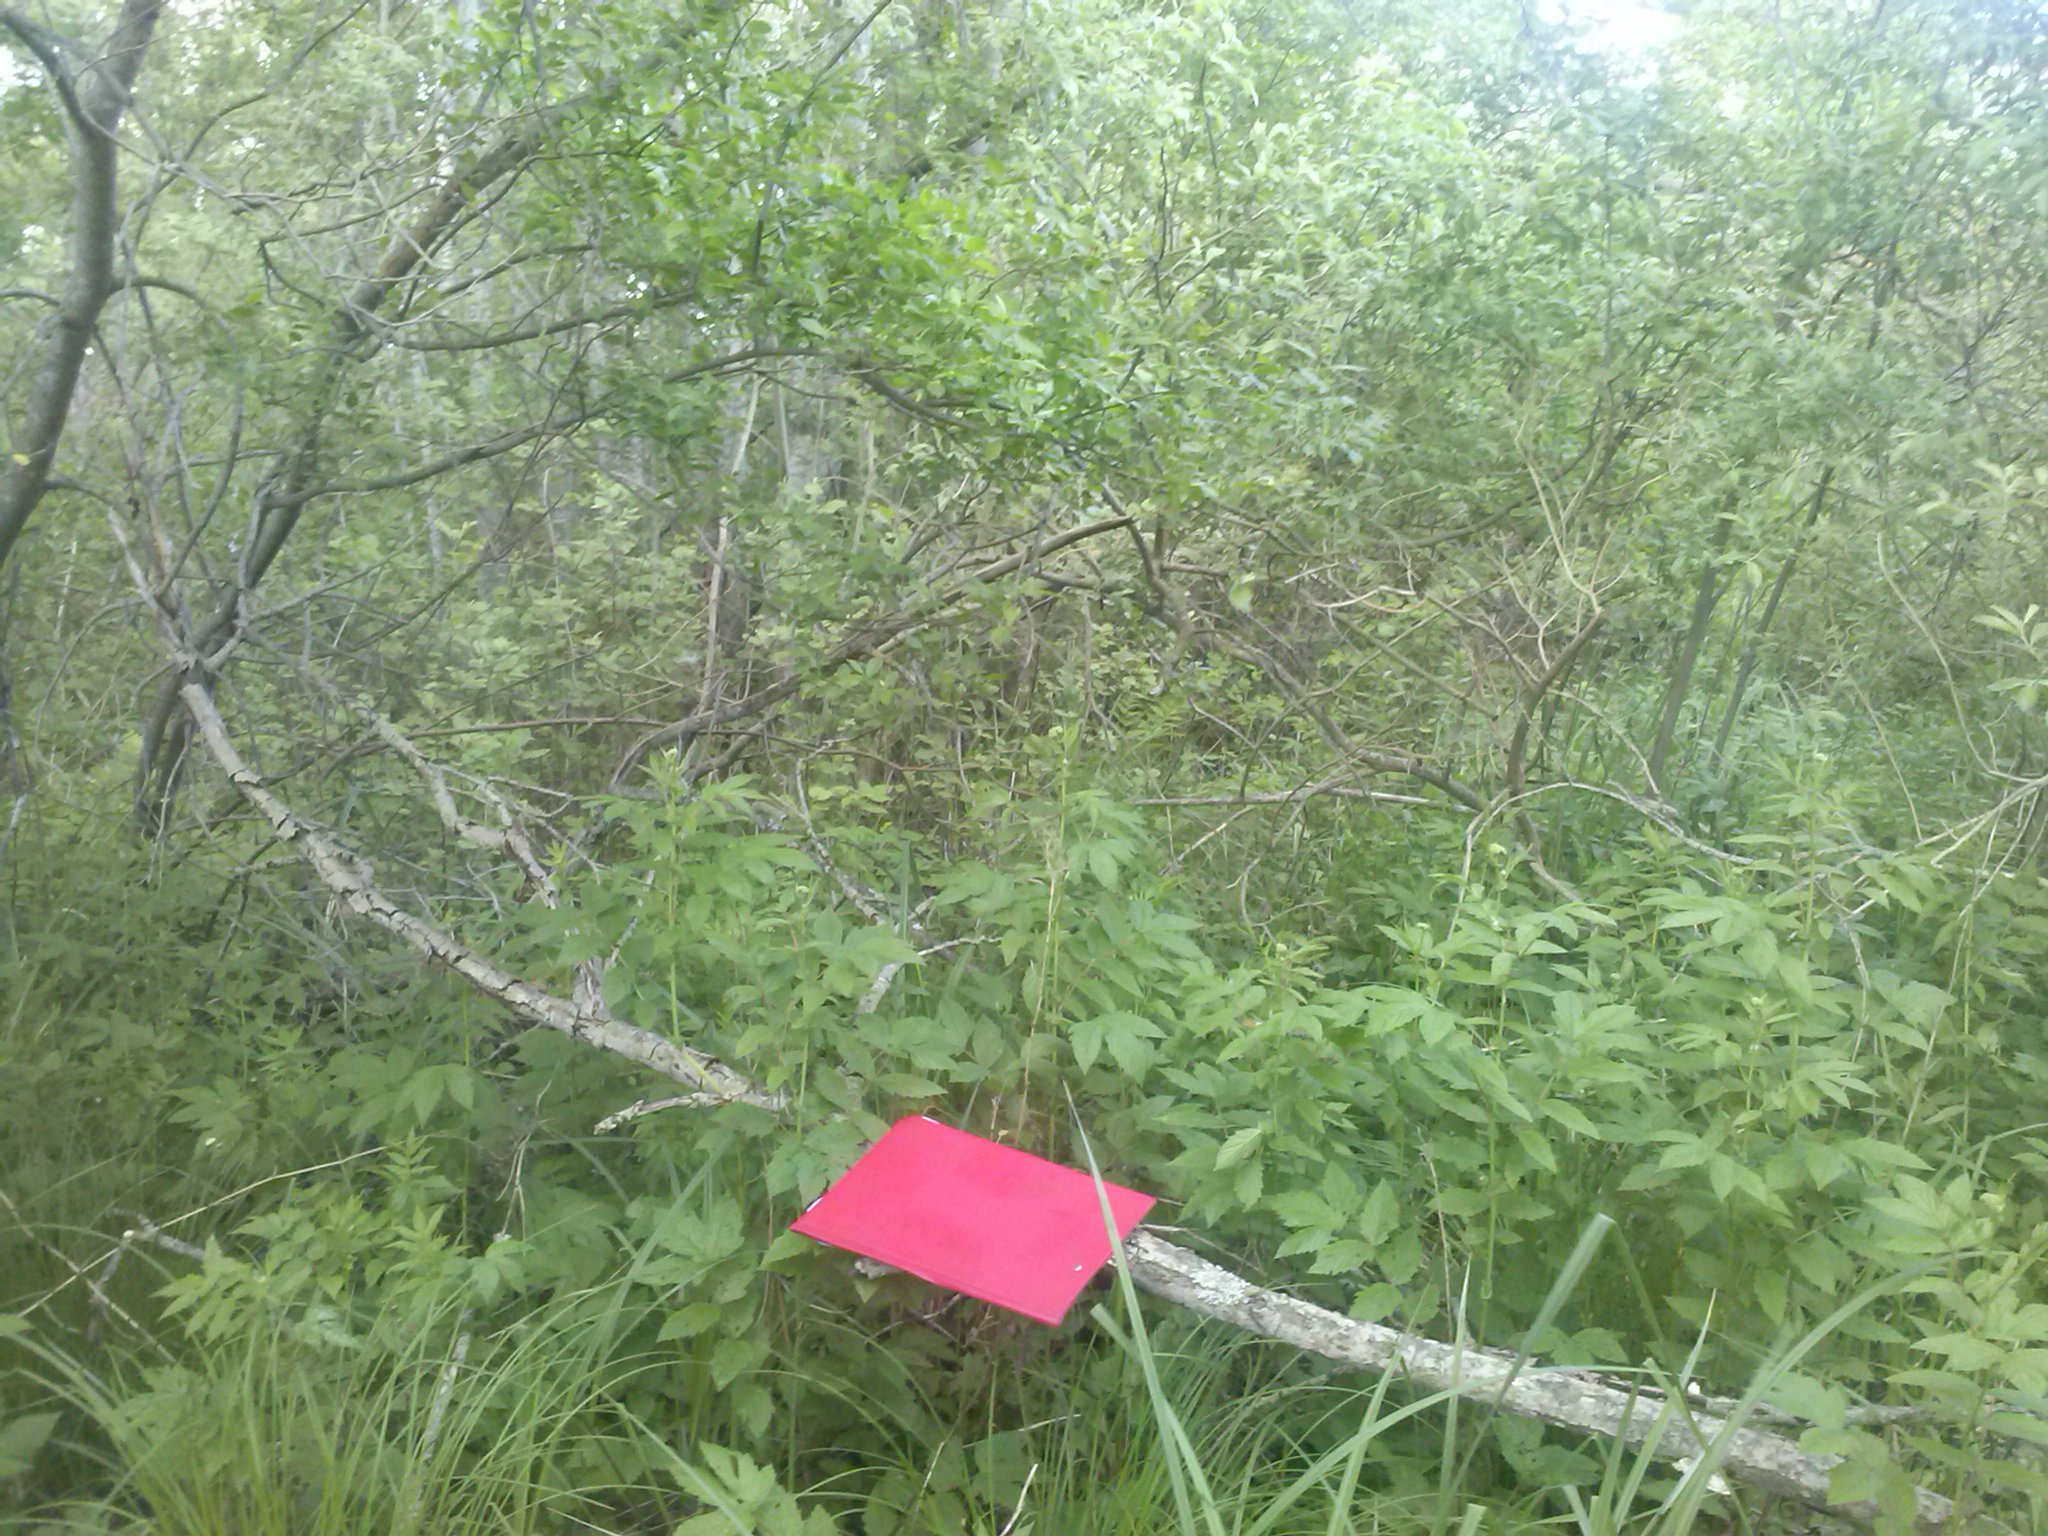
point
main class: Woodland
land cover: Broadleaved woodland
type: non-riverine alder, birch or aspen forest
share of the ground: > 75 %
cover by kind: broadleaved forest trees 90 %, herbaceous plants 10 %
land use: Forestry
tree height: > 5 m
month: June
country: LV
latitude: 56.3444
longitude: 27.5751
